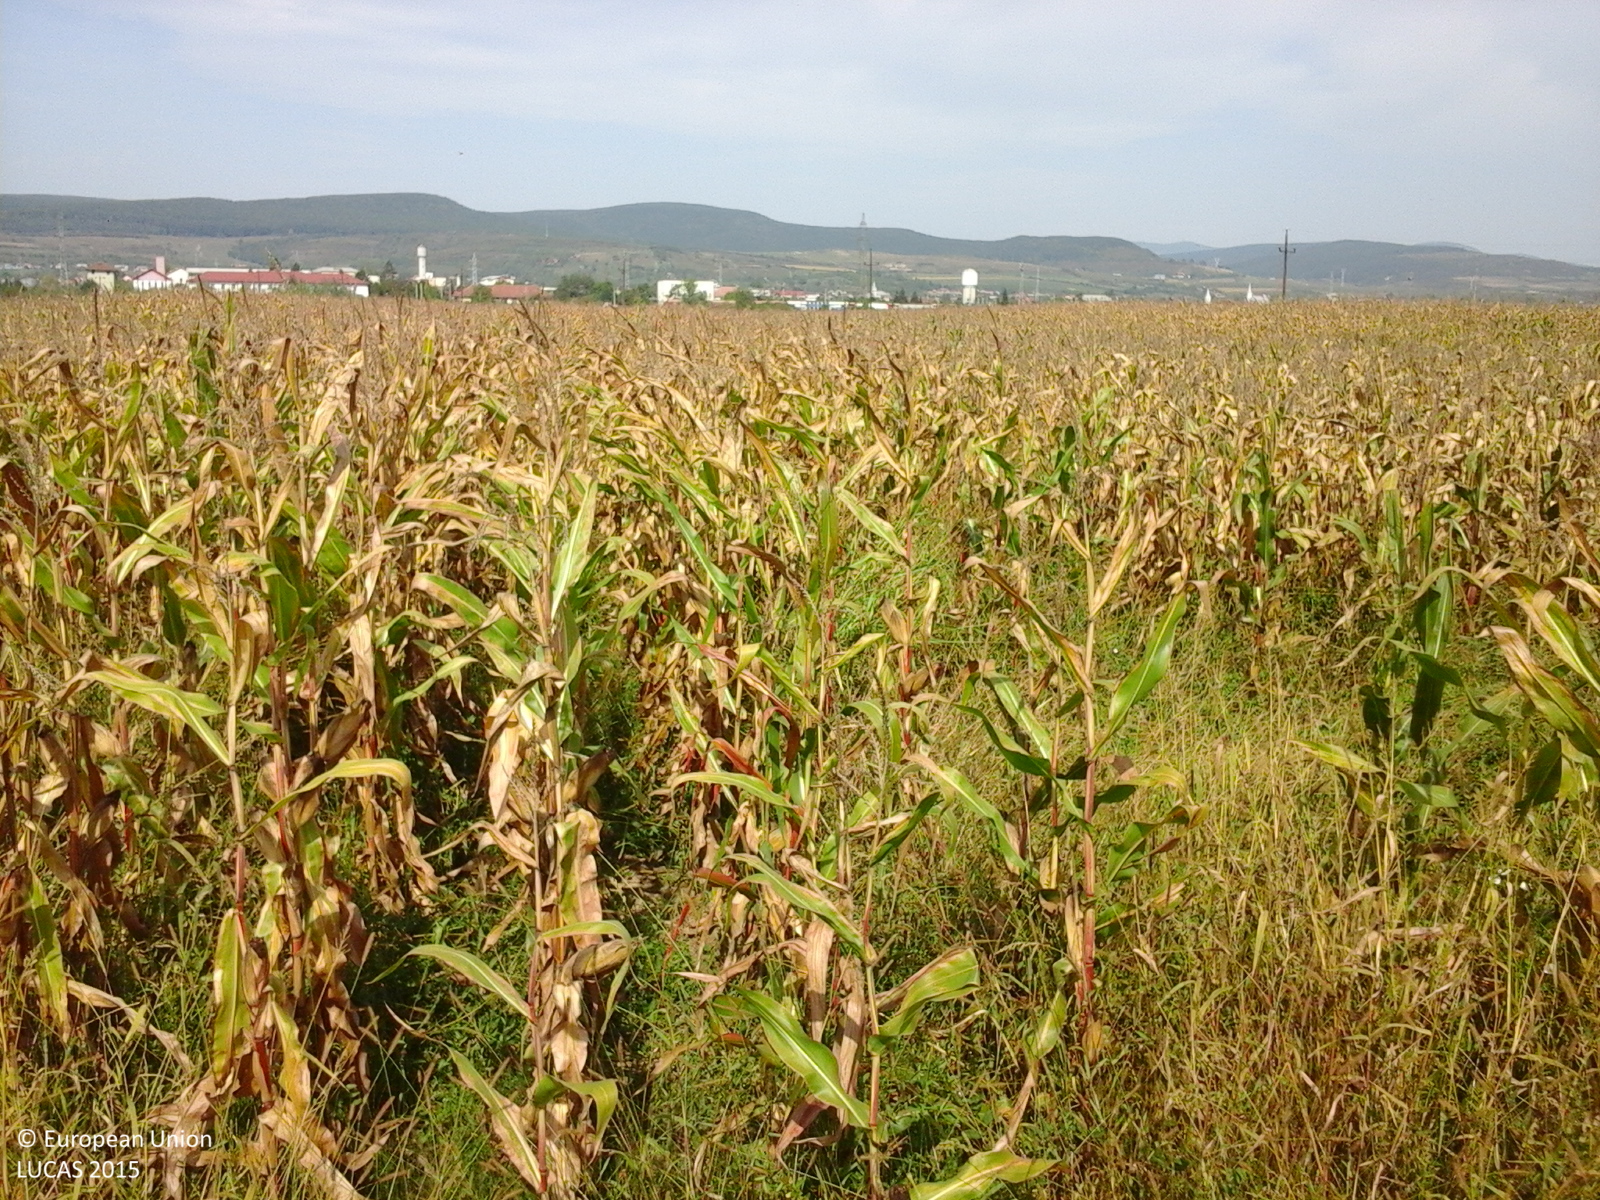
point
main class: Cropland
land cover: Maize
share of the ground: > 75 %
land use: Agriculture (excluding fallow land and kitchen gardens)
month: September
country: RO
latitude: 47.1531
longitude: 23.9145
